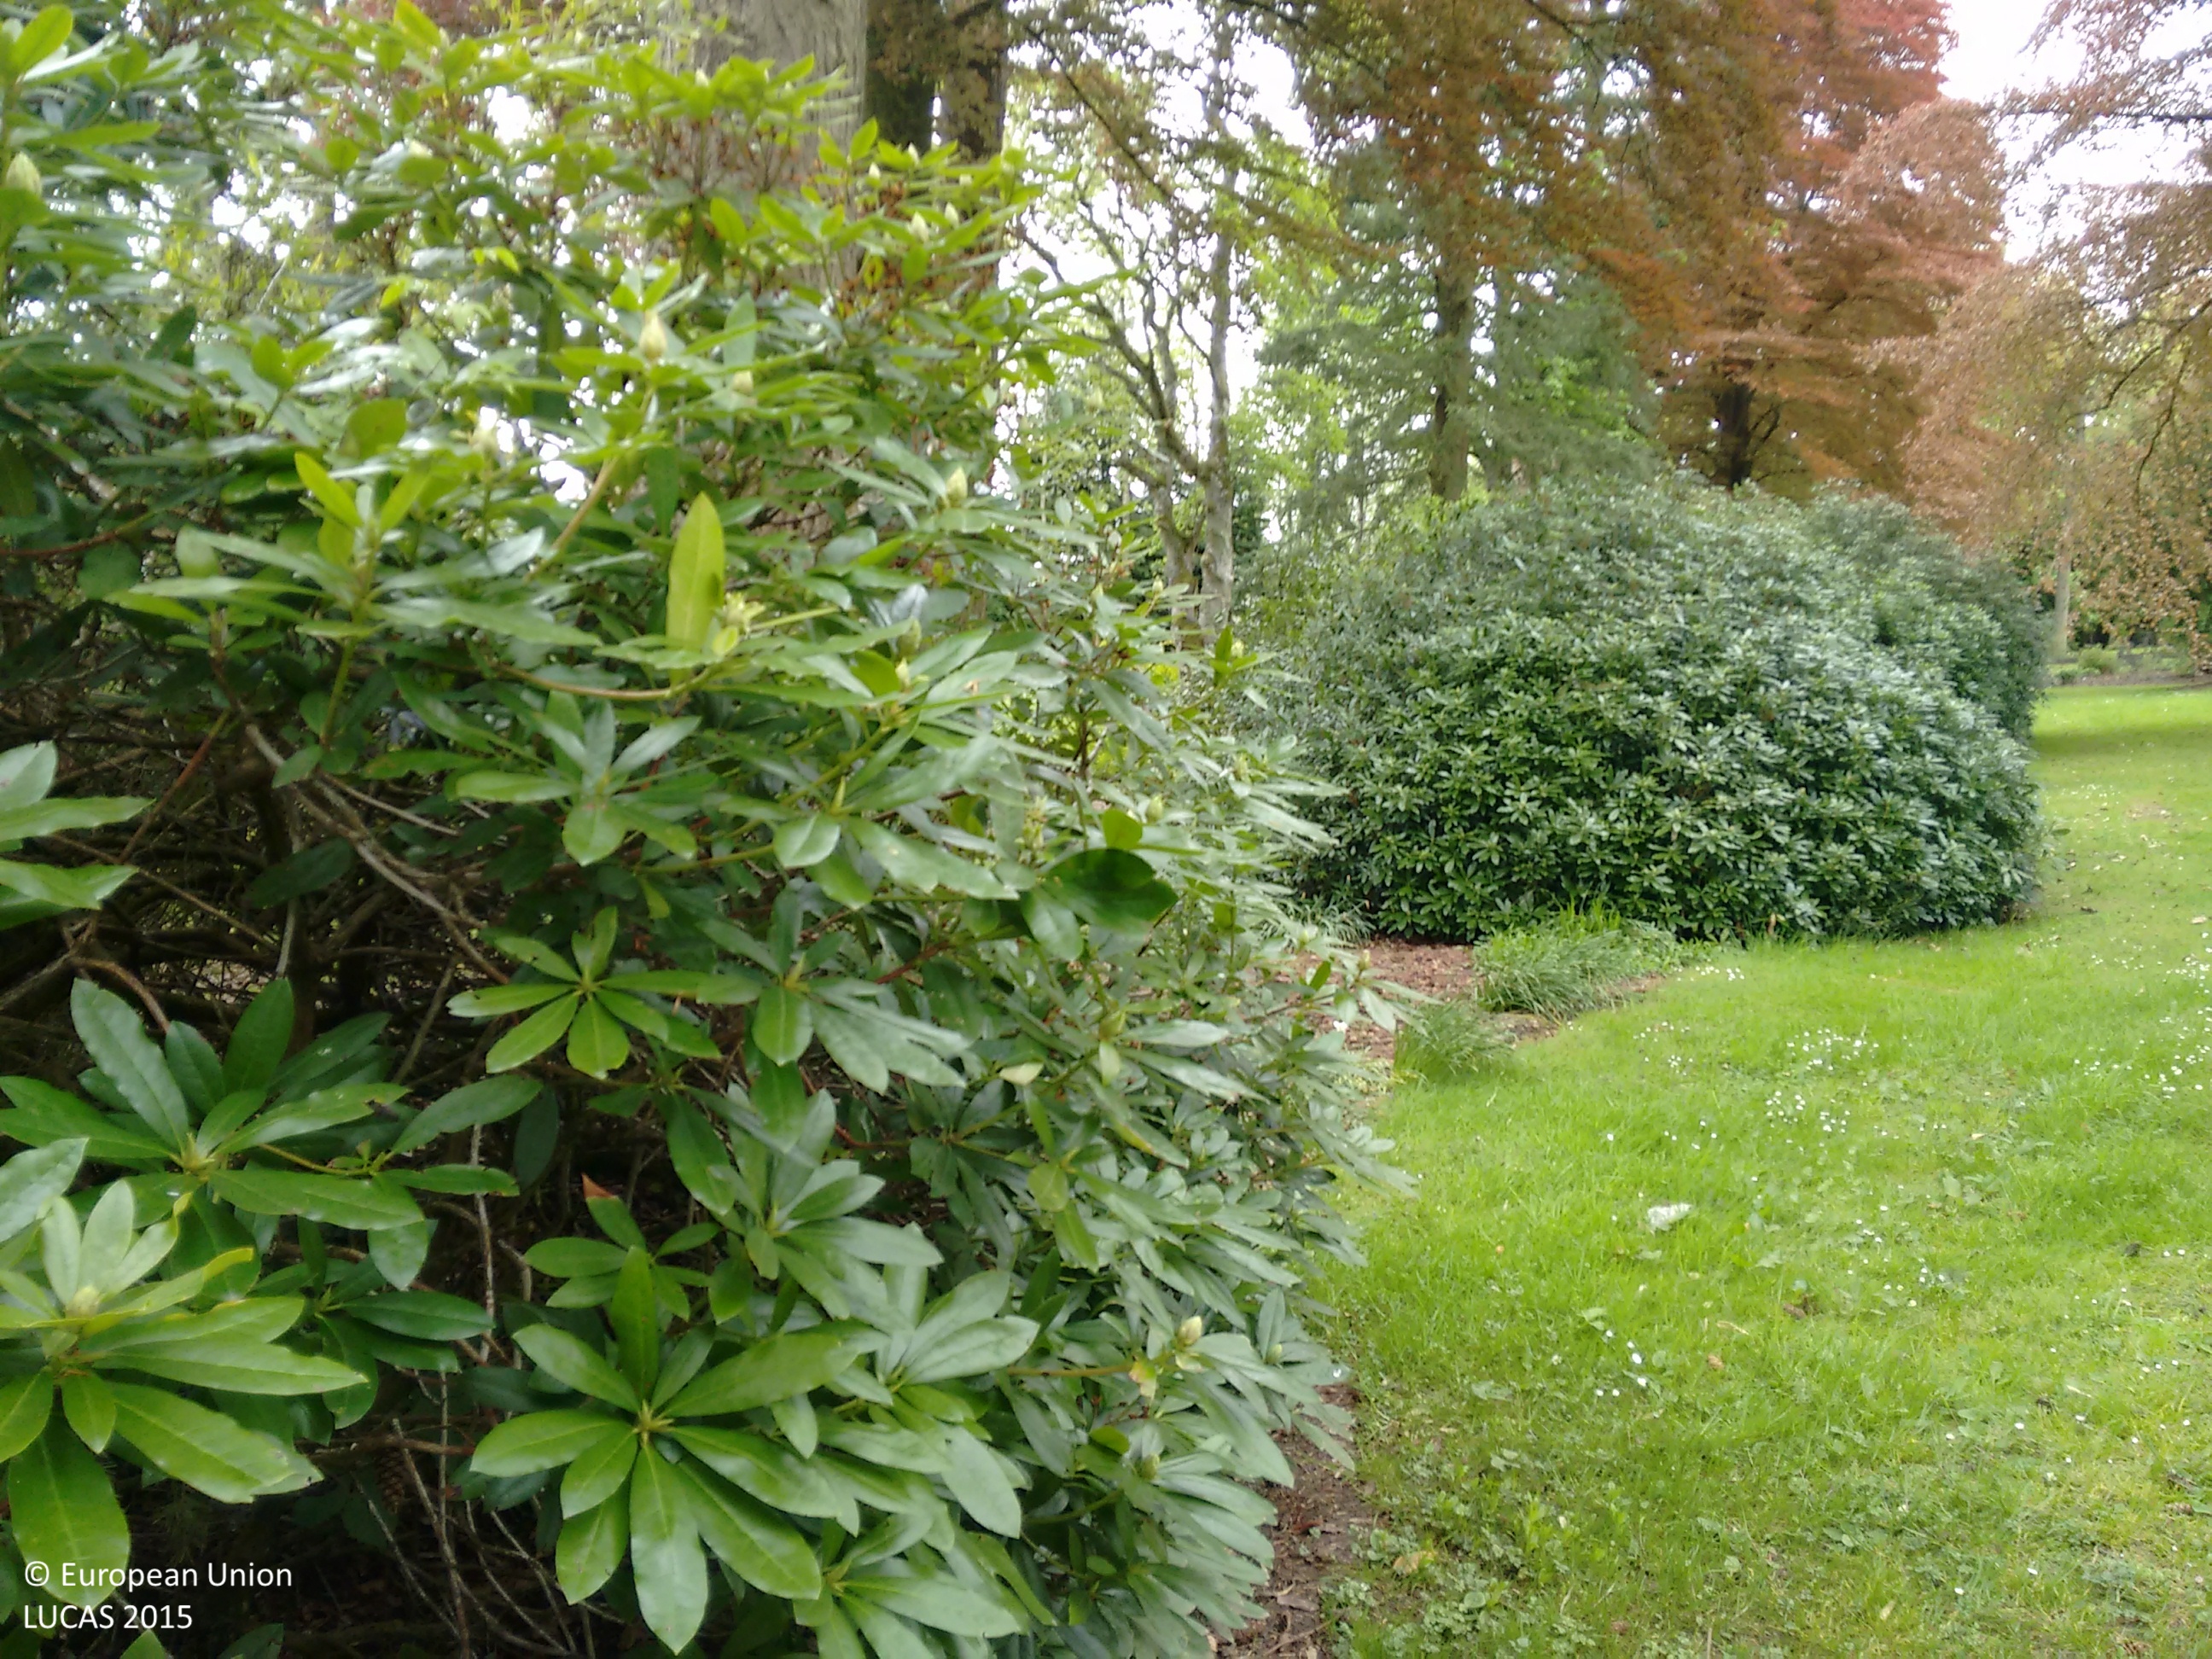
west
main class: Woodland
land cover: Other mixed woodland
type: exotic forest
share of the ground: > 75 %
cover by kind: broadleaved forest trees 45 %, coniferous forest trees 20 %, shrubs 20 %, herbaceous plants 15 %
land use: Residential
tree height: > 5 m
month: May
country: GB
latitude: 56.3171
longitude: -3.7752
